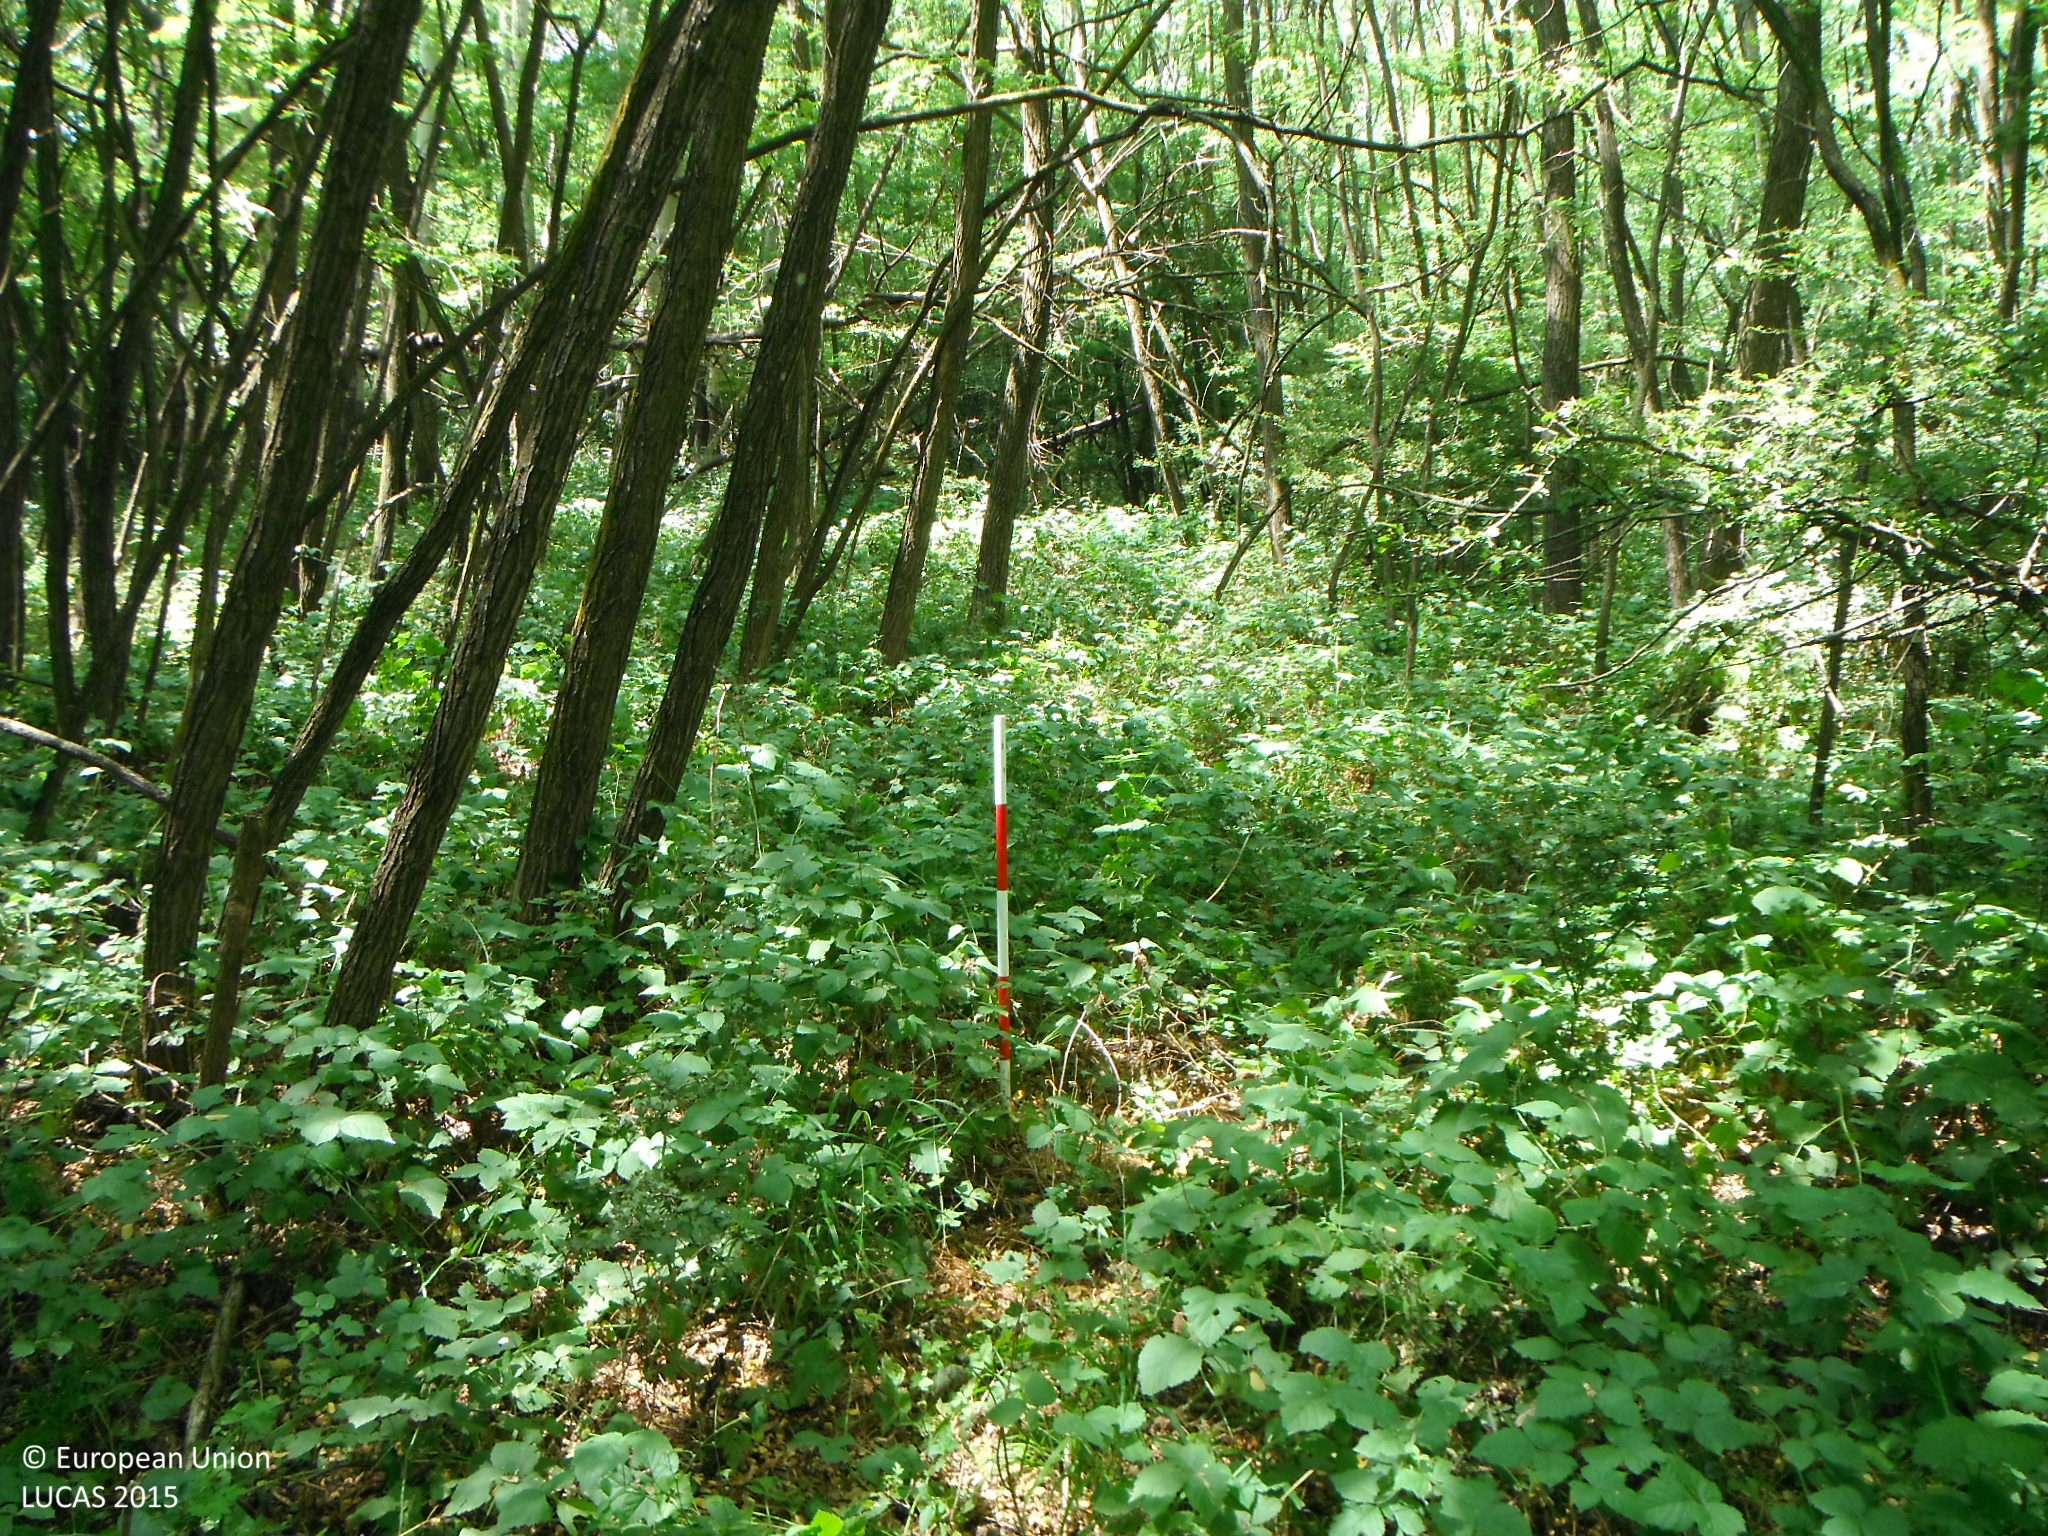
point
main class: Woodland
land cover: Broadleaved woodland
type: mesophytic deciduous forest
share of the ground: > 75 %
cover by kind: broadleaved forest trees 100 %
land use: Forestry
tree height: > 5 m
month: July
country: SK
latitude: 48.2596
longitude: 19.1404
